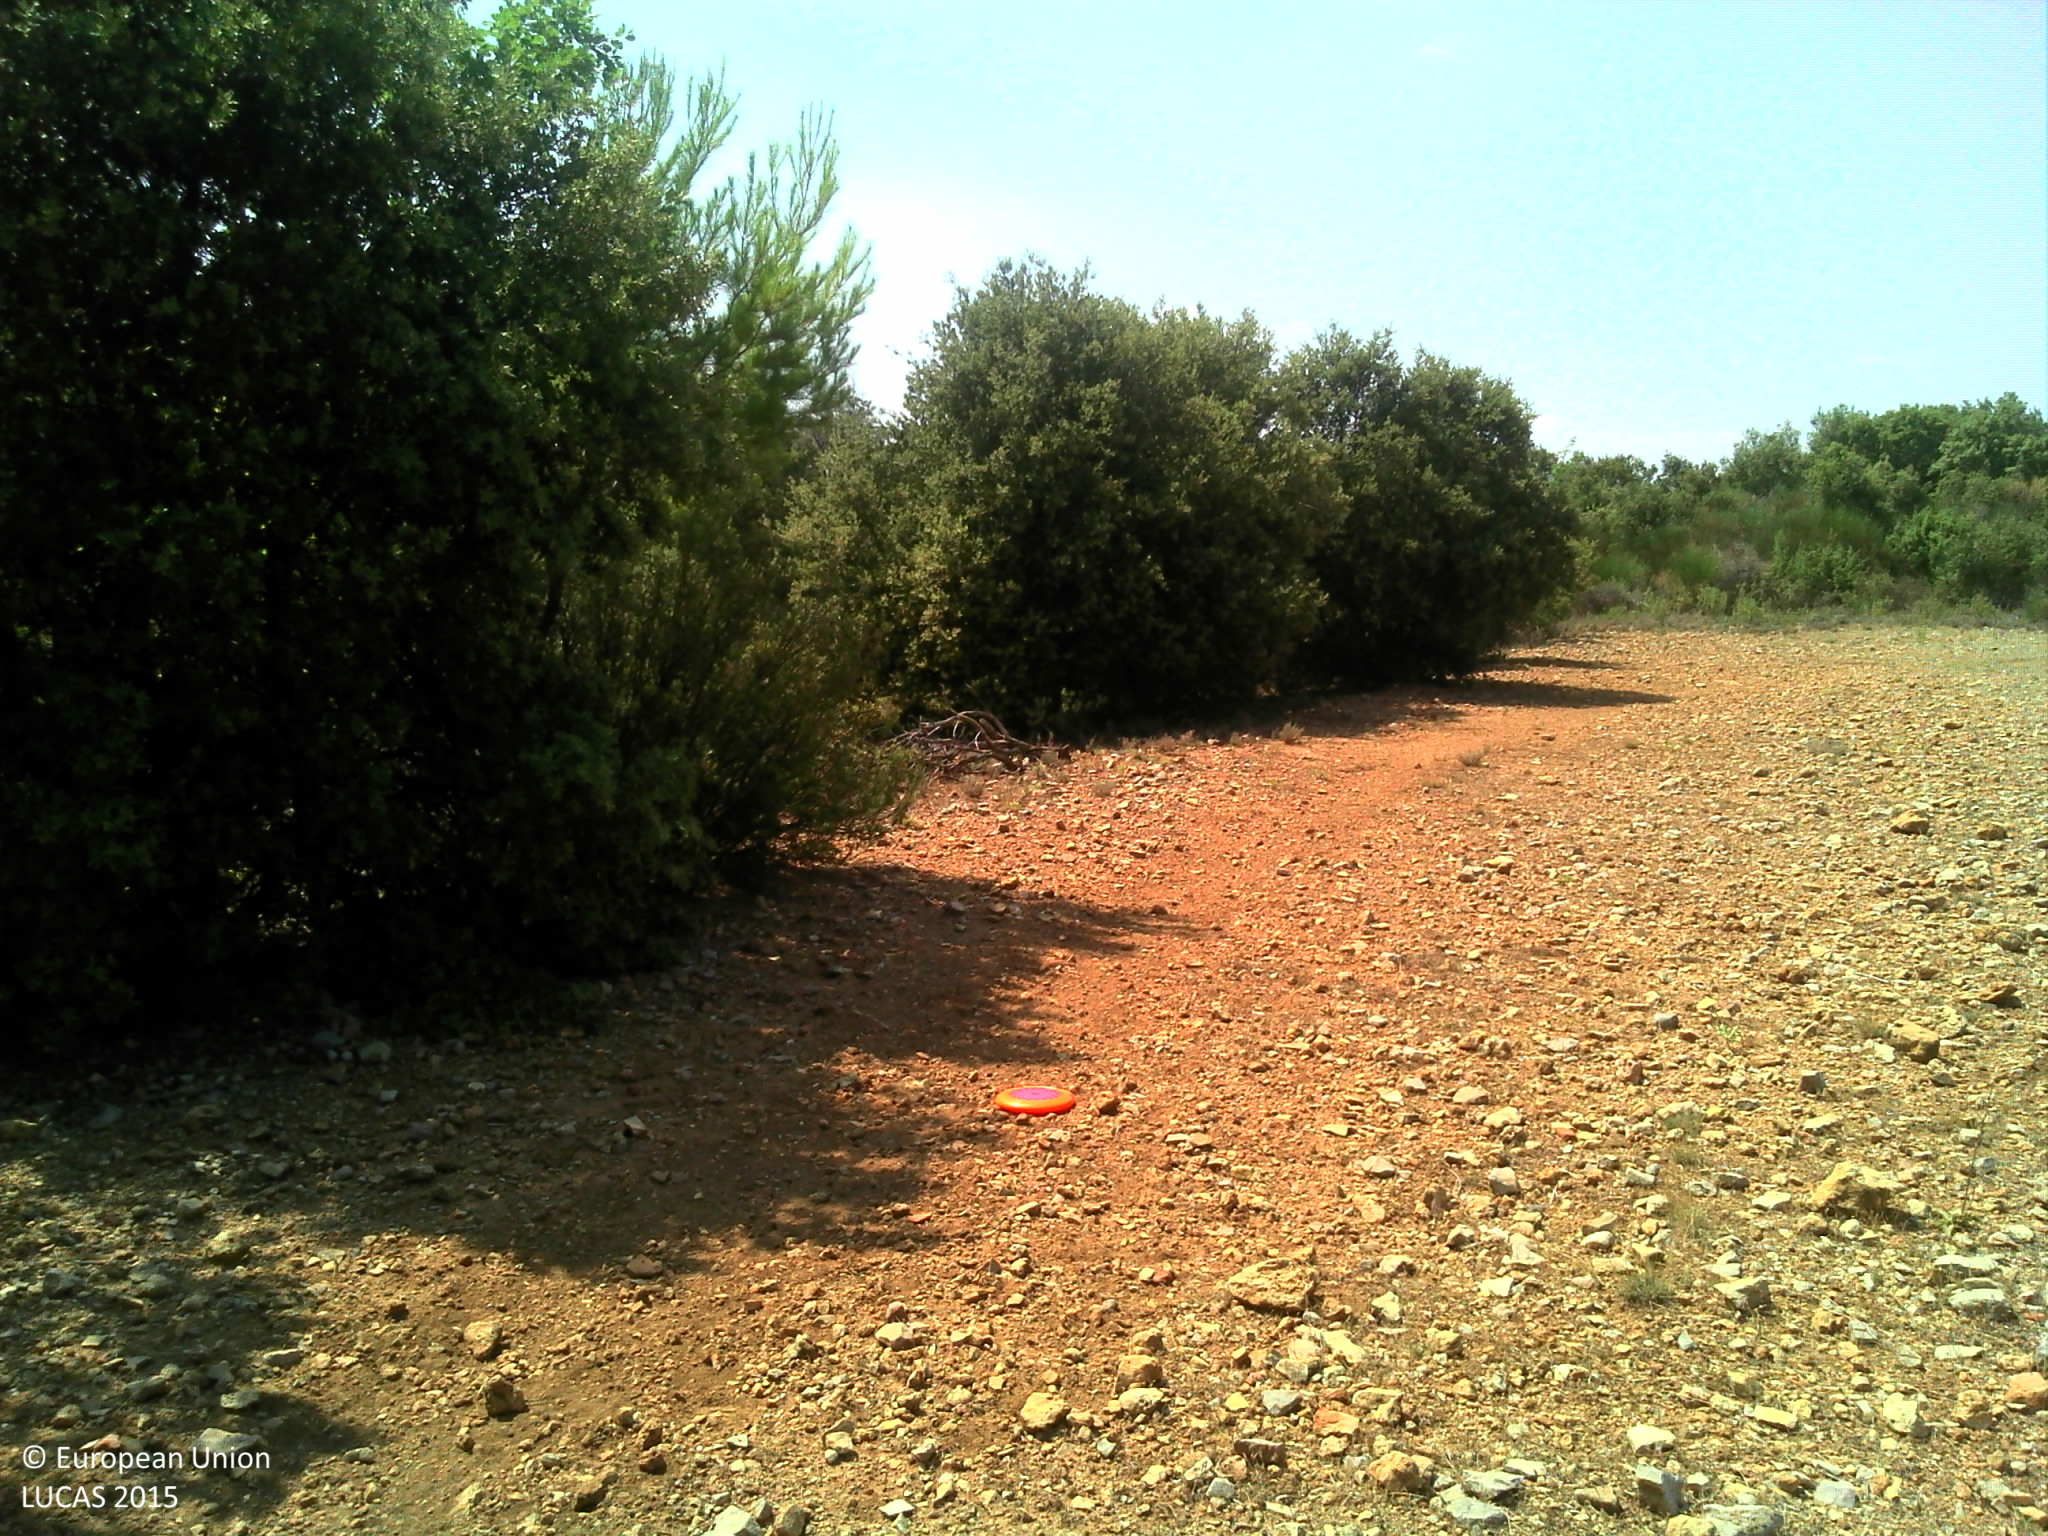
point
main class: Grassland
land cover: Spontaneously vegetated surfaces
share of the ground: > 75 %
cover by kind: herbaceous plants 75 %, unconsolidated bare surface 20 %, shrubs 5 %
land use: Semi-natural and natural areas not in use
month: August
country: FR
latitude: 43.5977
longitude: 6.2800
